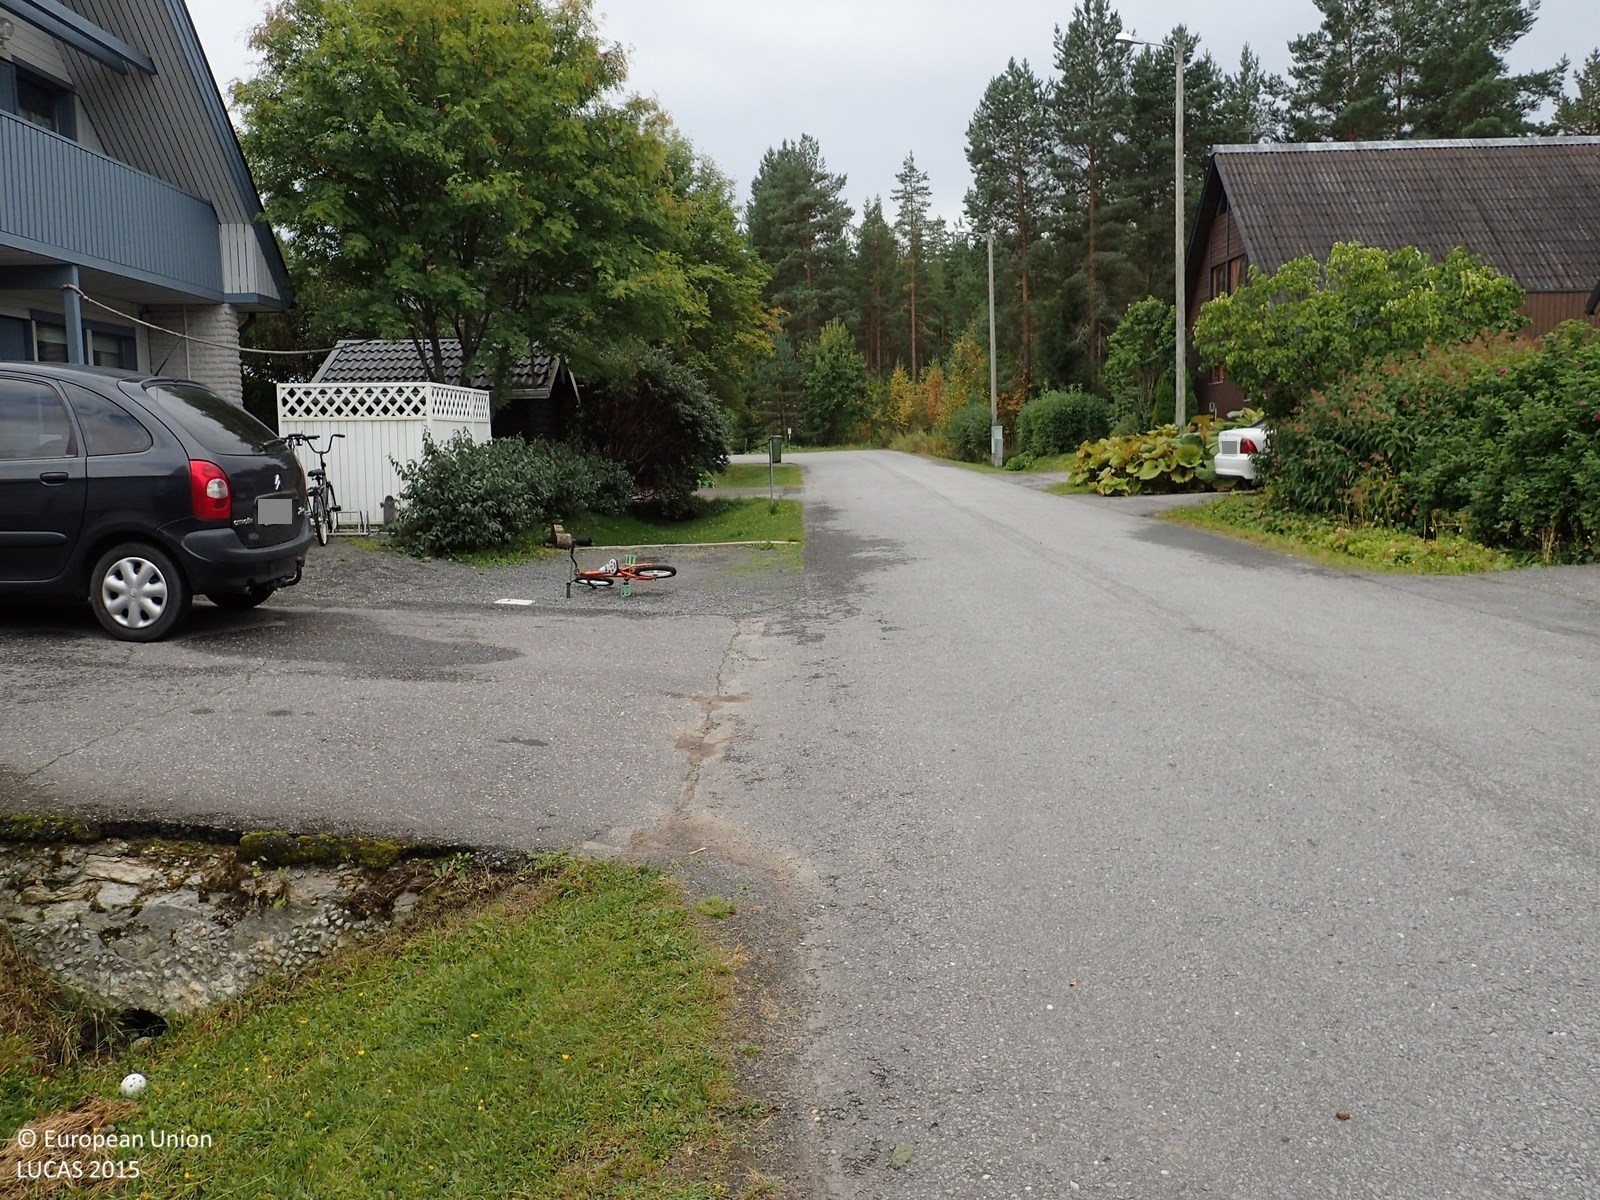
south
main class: Woodland
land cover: Broadleaved woodland
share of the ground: > 75 %
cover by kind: broadleaved forest trees 85 %, herbaceous plants 15 %
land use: Residential
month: August
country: FI
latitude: 62.7797
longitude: 22.7752
